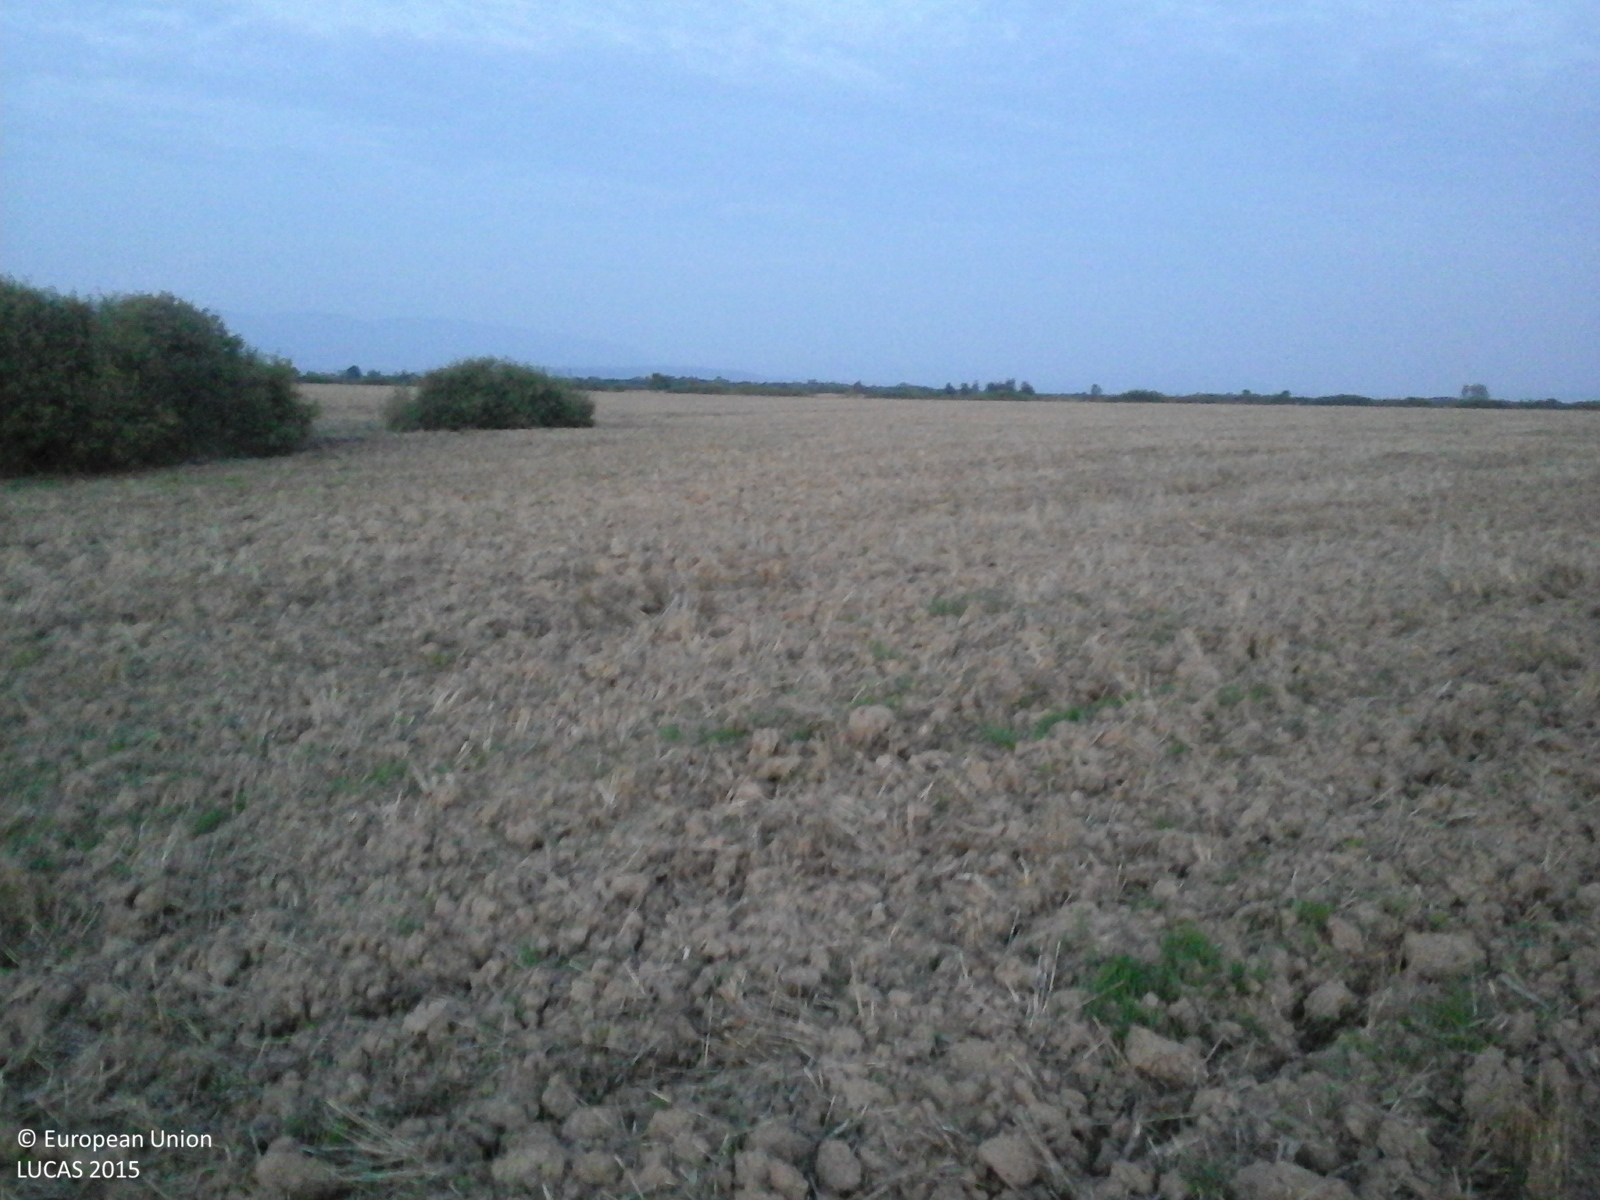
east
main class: Cropland
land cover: Common wheat
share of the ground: < 10 %
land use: Agriculture (excluding fallow land and kitchen gardens)
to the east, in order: Common wheat
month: August
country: RO
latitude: 46.4660
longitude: 21.9060
